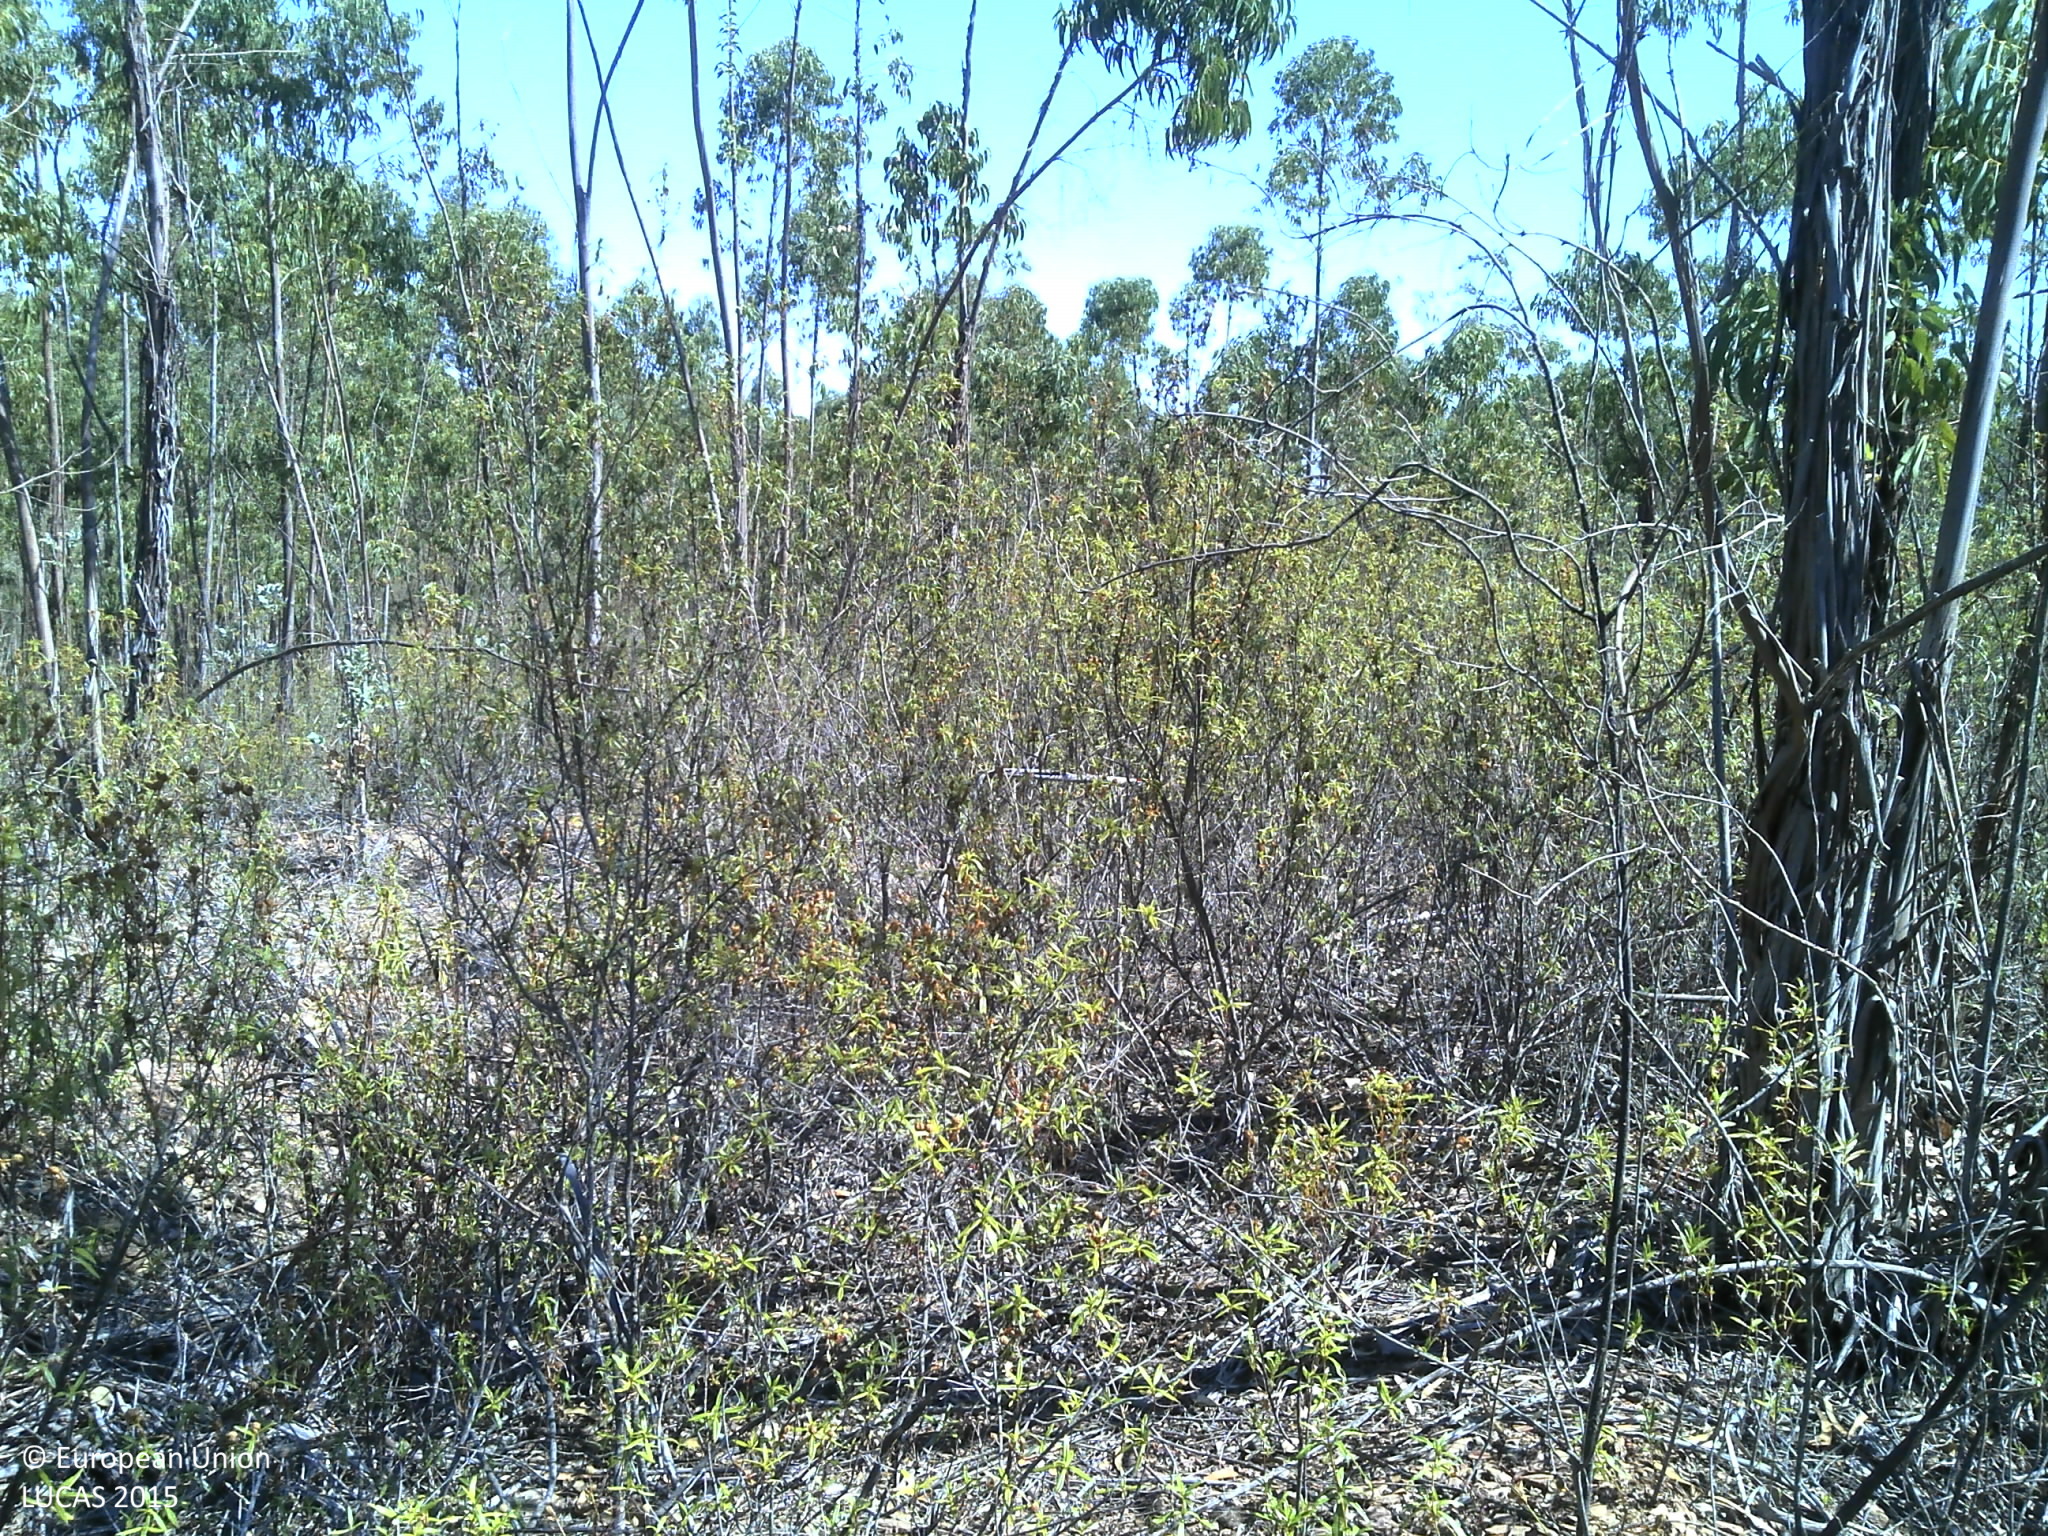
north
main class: Woodland
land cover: Broadleaved woodland
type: exotic forest
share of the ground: 10 - 25 %
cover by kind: shrubs 75 %, broadleaved forest trees 25 %
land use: Forestry
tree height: > 5 m
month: July
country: PT
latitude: 38.5914
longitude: -7.2812
